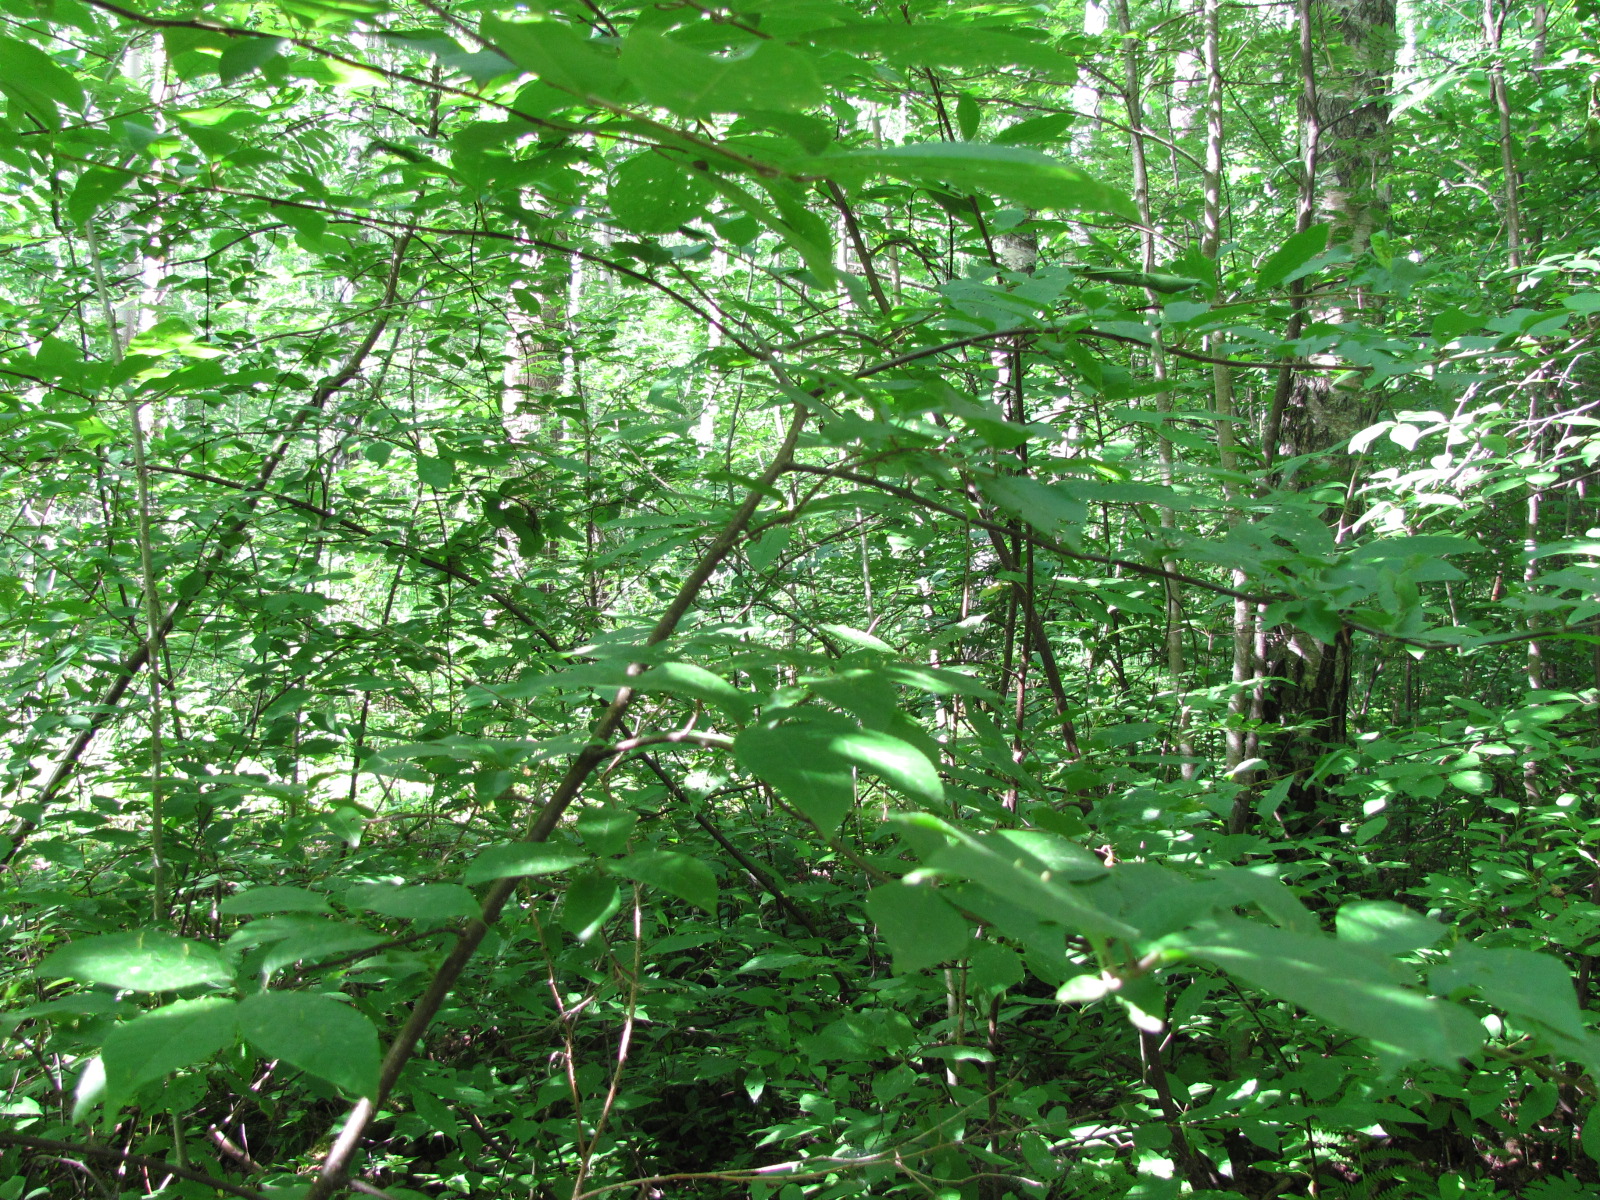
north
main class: Woodland
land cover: Broadleaved woodland
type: non-riverine alder, birch or aspen forest
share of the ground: > 75 %
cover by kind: broadleaved forest trees 100 %
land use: Forestry
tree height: > 5 m
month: June
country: LV
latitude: 56.8725
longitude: 24.3818
